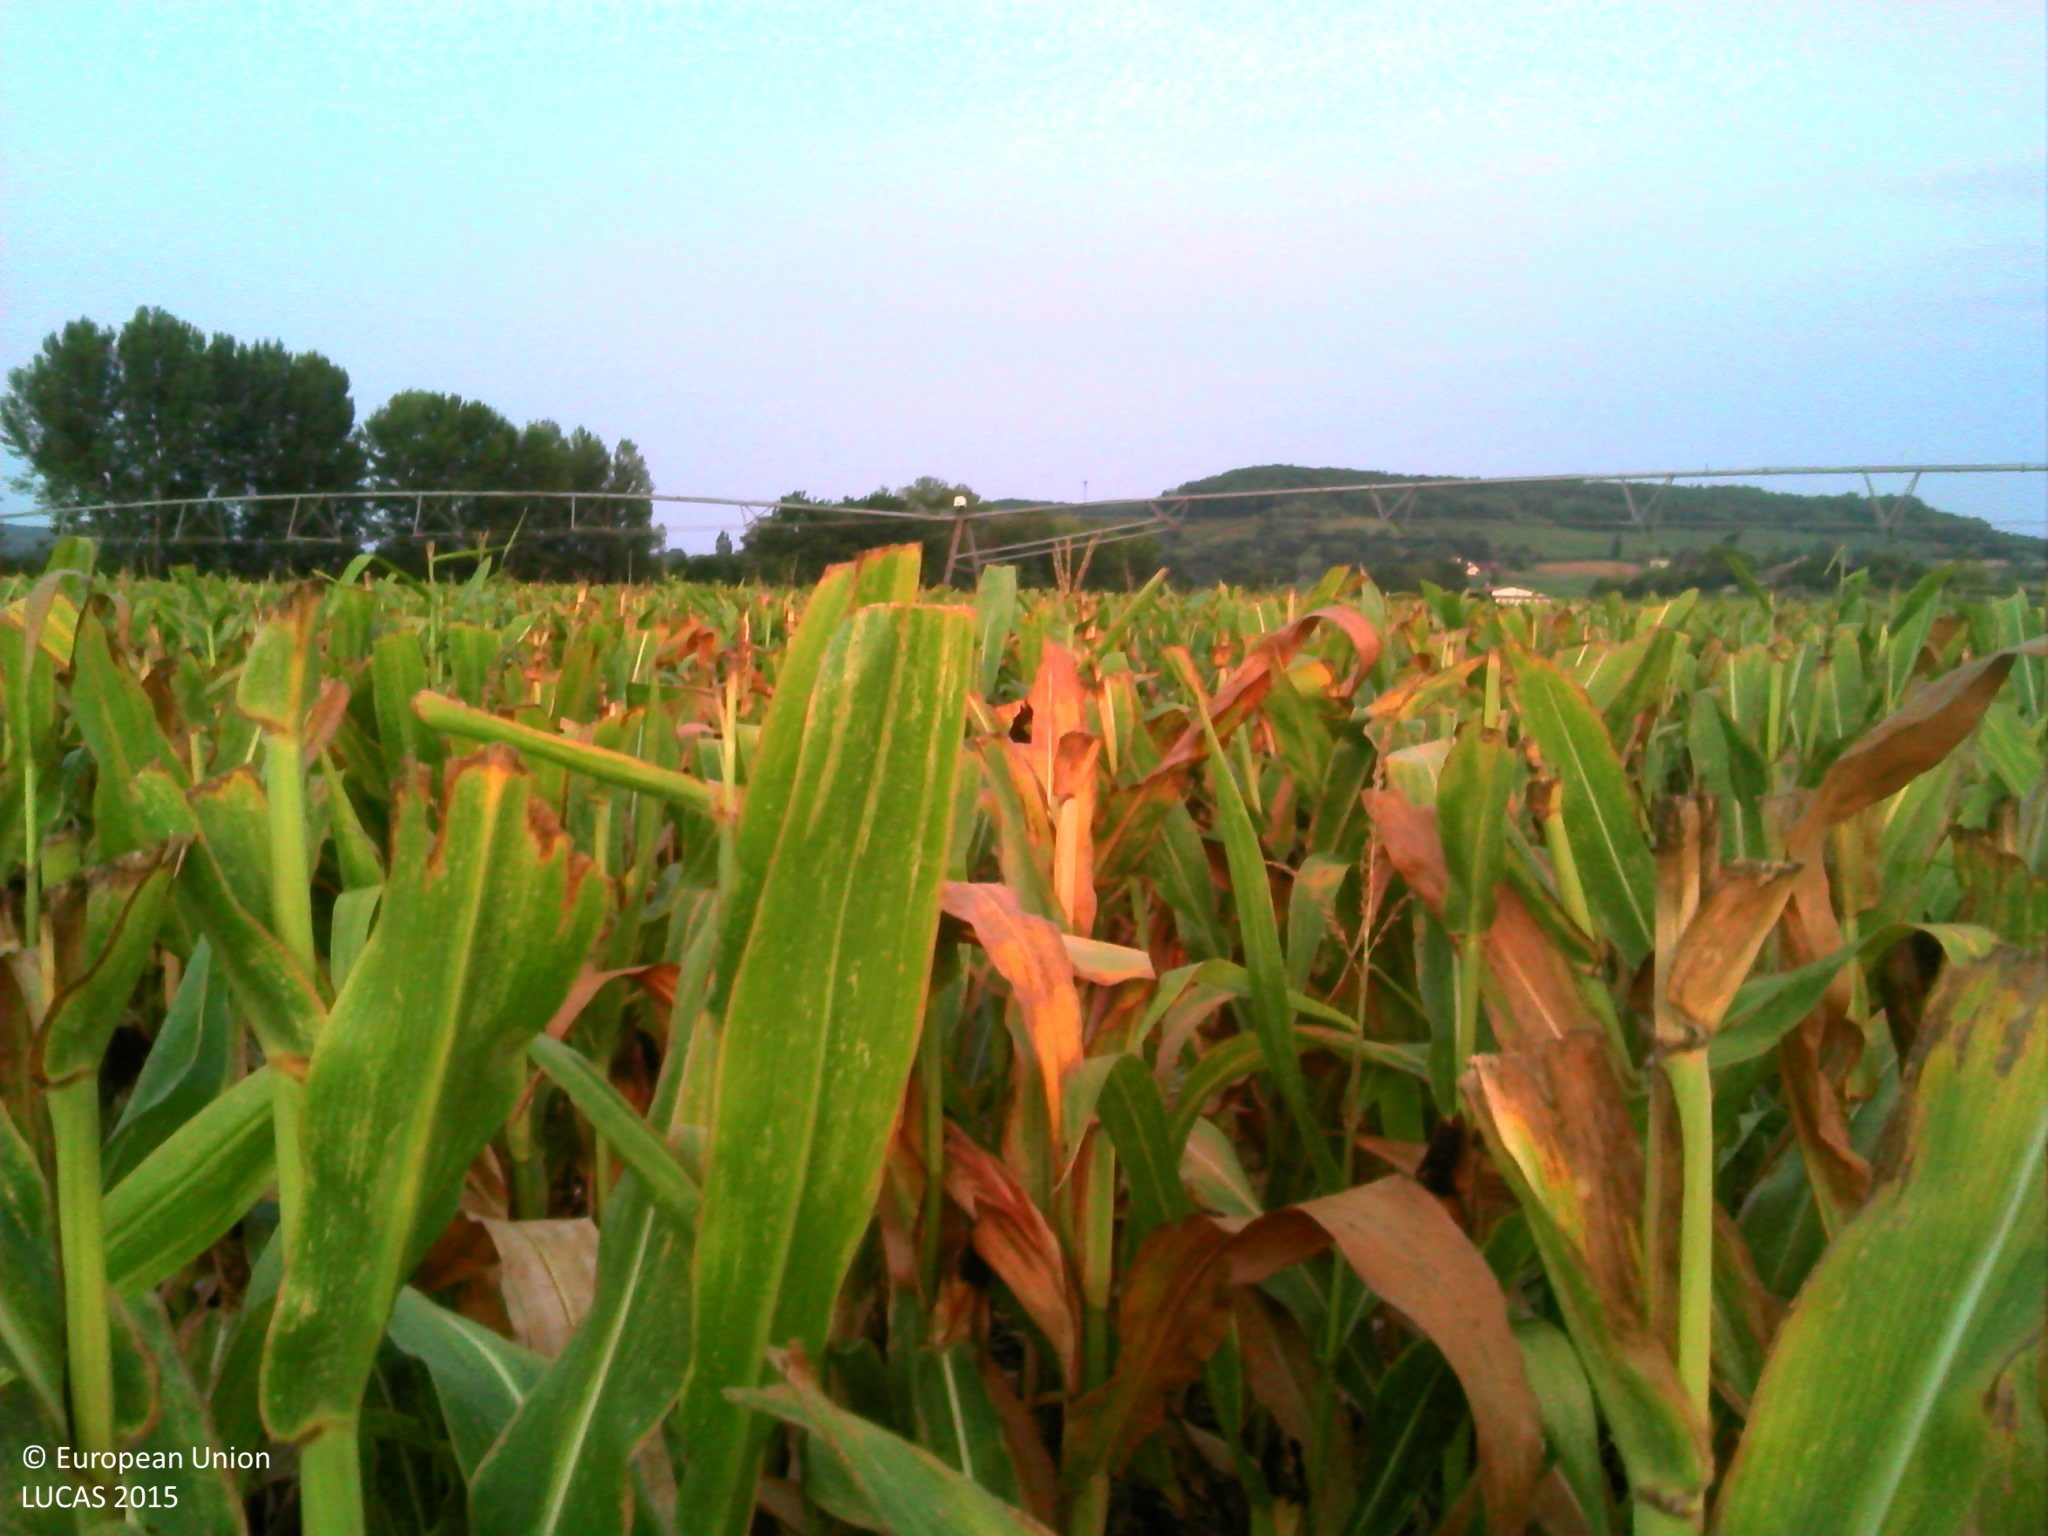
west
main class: Cropland
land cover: Maize
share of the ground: > 75 %
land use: Agriculture (excluding fallow land and kitchen gardens)
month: August
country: FR
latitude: 44.2855
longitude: 1.2135
